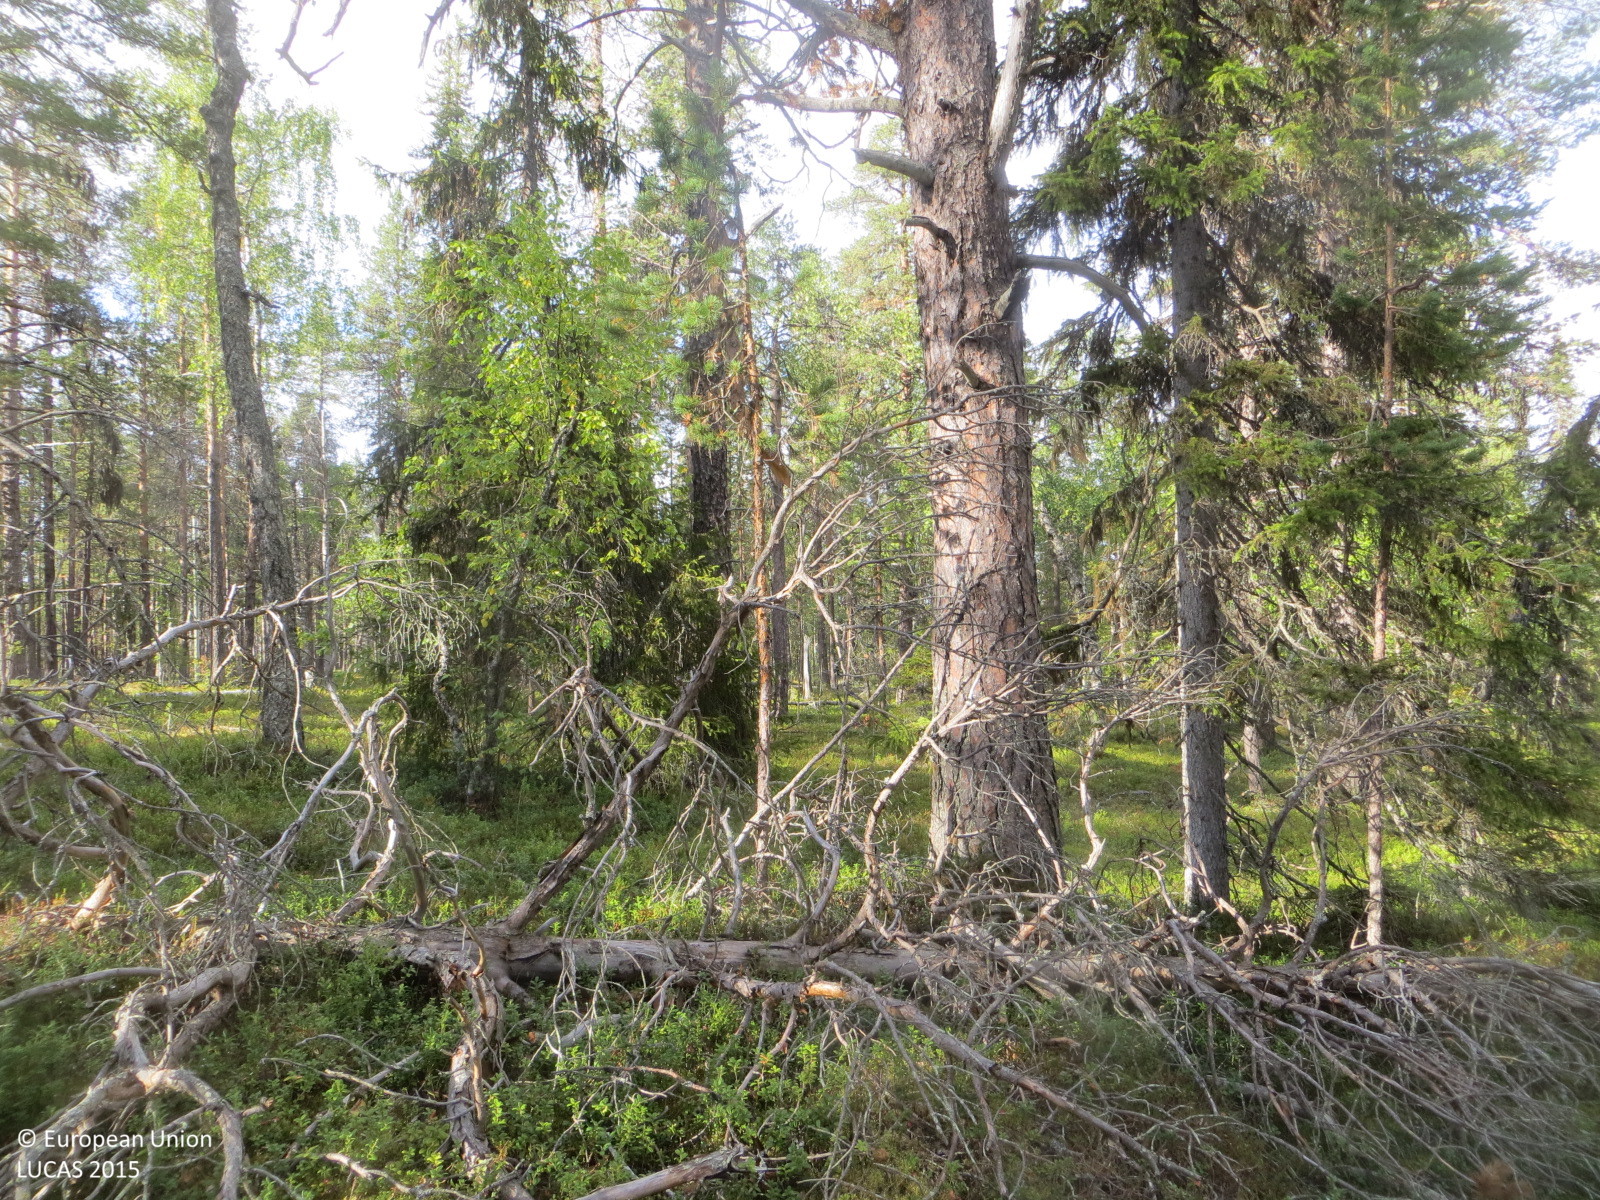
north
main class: Woodland
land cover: Other coniferous woodland
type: boreal forest
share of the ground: 50 - 75 %
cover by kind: coniferous forest trees 50 %, shrubs 50 %
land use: Semi-natural and natural areas not in use
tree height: > 5 m
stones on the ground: < 10 %
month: September
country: FI
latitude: 67.9583
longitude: 24.0332
